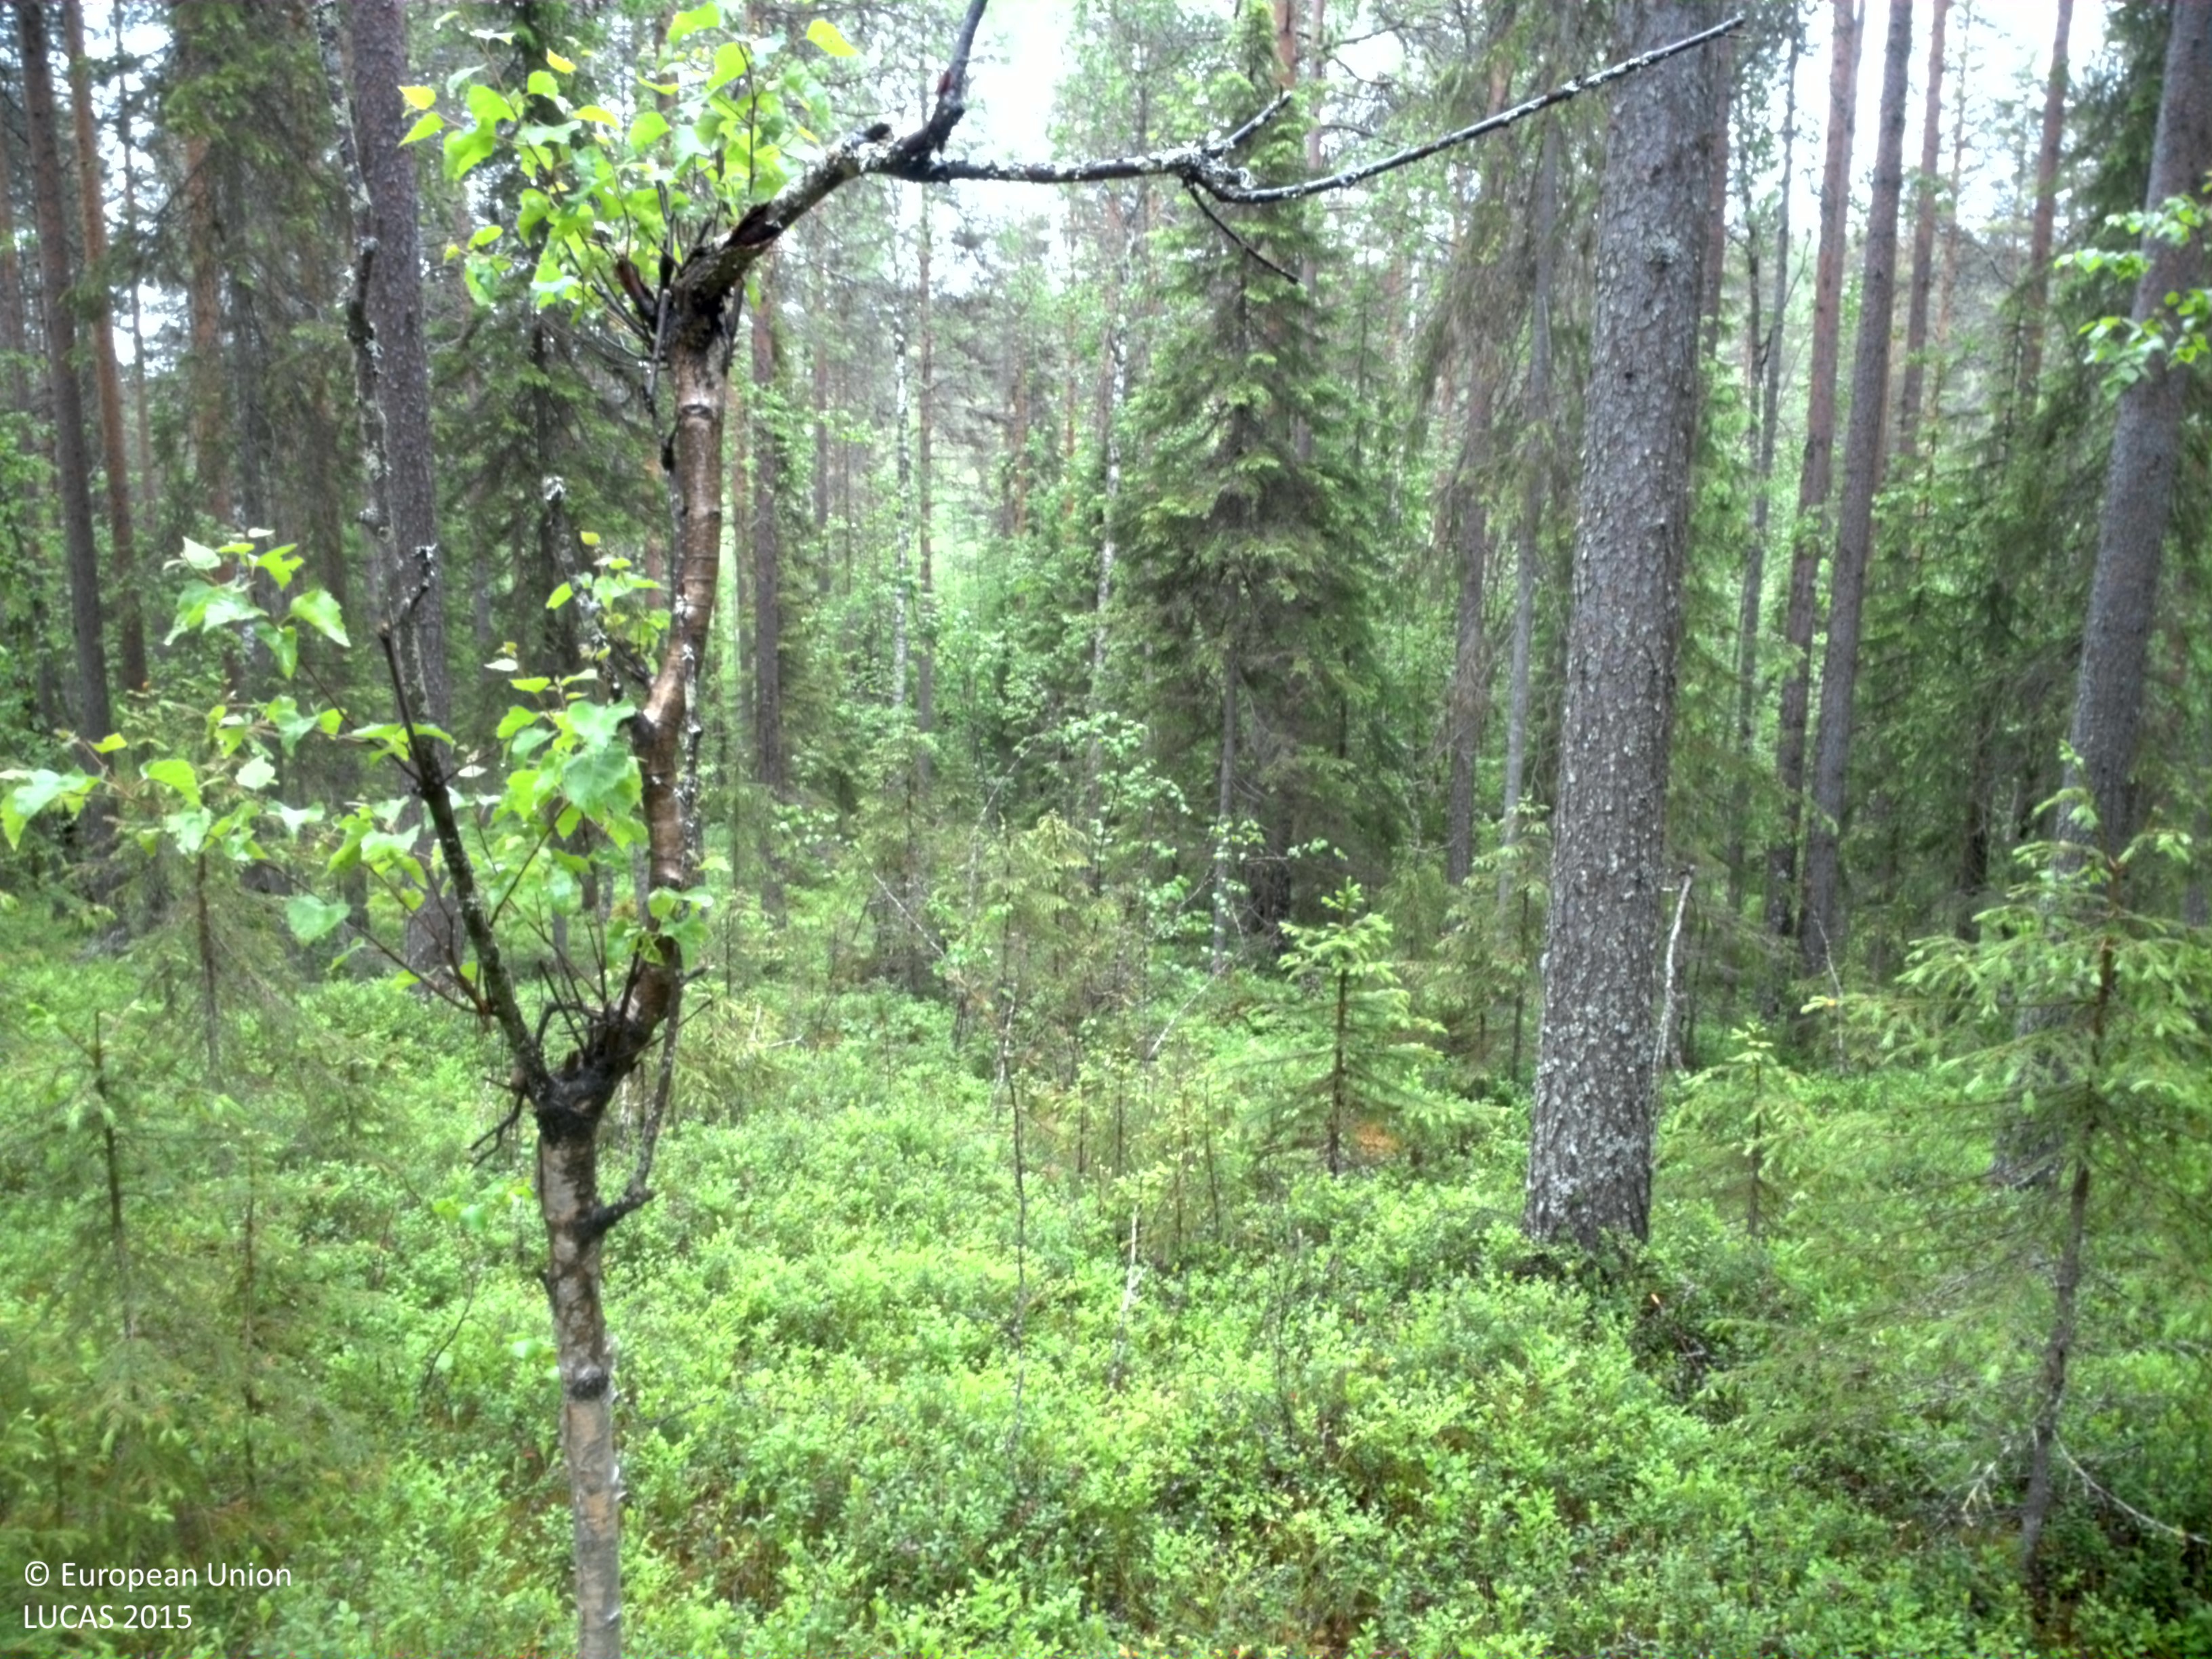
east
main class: Woodland
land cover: Pine dominated coniferous woodland
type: boreal forest
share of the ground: 50 - 75 %
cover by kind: coniferous forest trees 45 %, shrubs 45 %, broadleaved forest trees 10 %
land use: Forestry
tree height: > 5 m
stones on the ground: 10 - 25 %
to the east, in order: Pine dominated coniferous woodland; Spruce dominated mixed woodland; Ditches and canals; Spruce dominated mixed woodland; Pine dominated mixed woodland; Ditches and canals; Broadleaved woodland; Pine dominated mixed woodland; Ditches and canals; Broadleaved woodland; Spruce dominated mixed woodland; Ditches and canals; Spruce dominated mixed woodland; Pine dominated coniferous woodland; Tracks; Pine dominated coniferous woodland
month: June
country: SE
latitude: 66.4713
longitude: 22.7479
